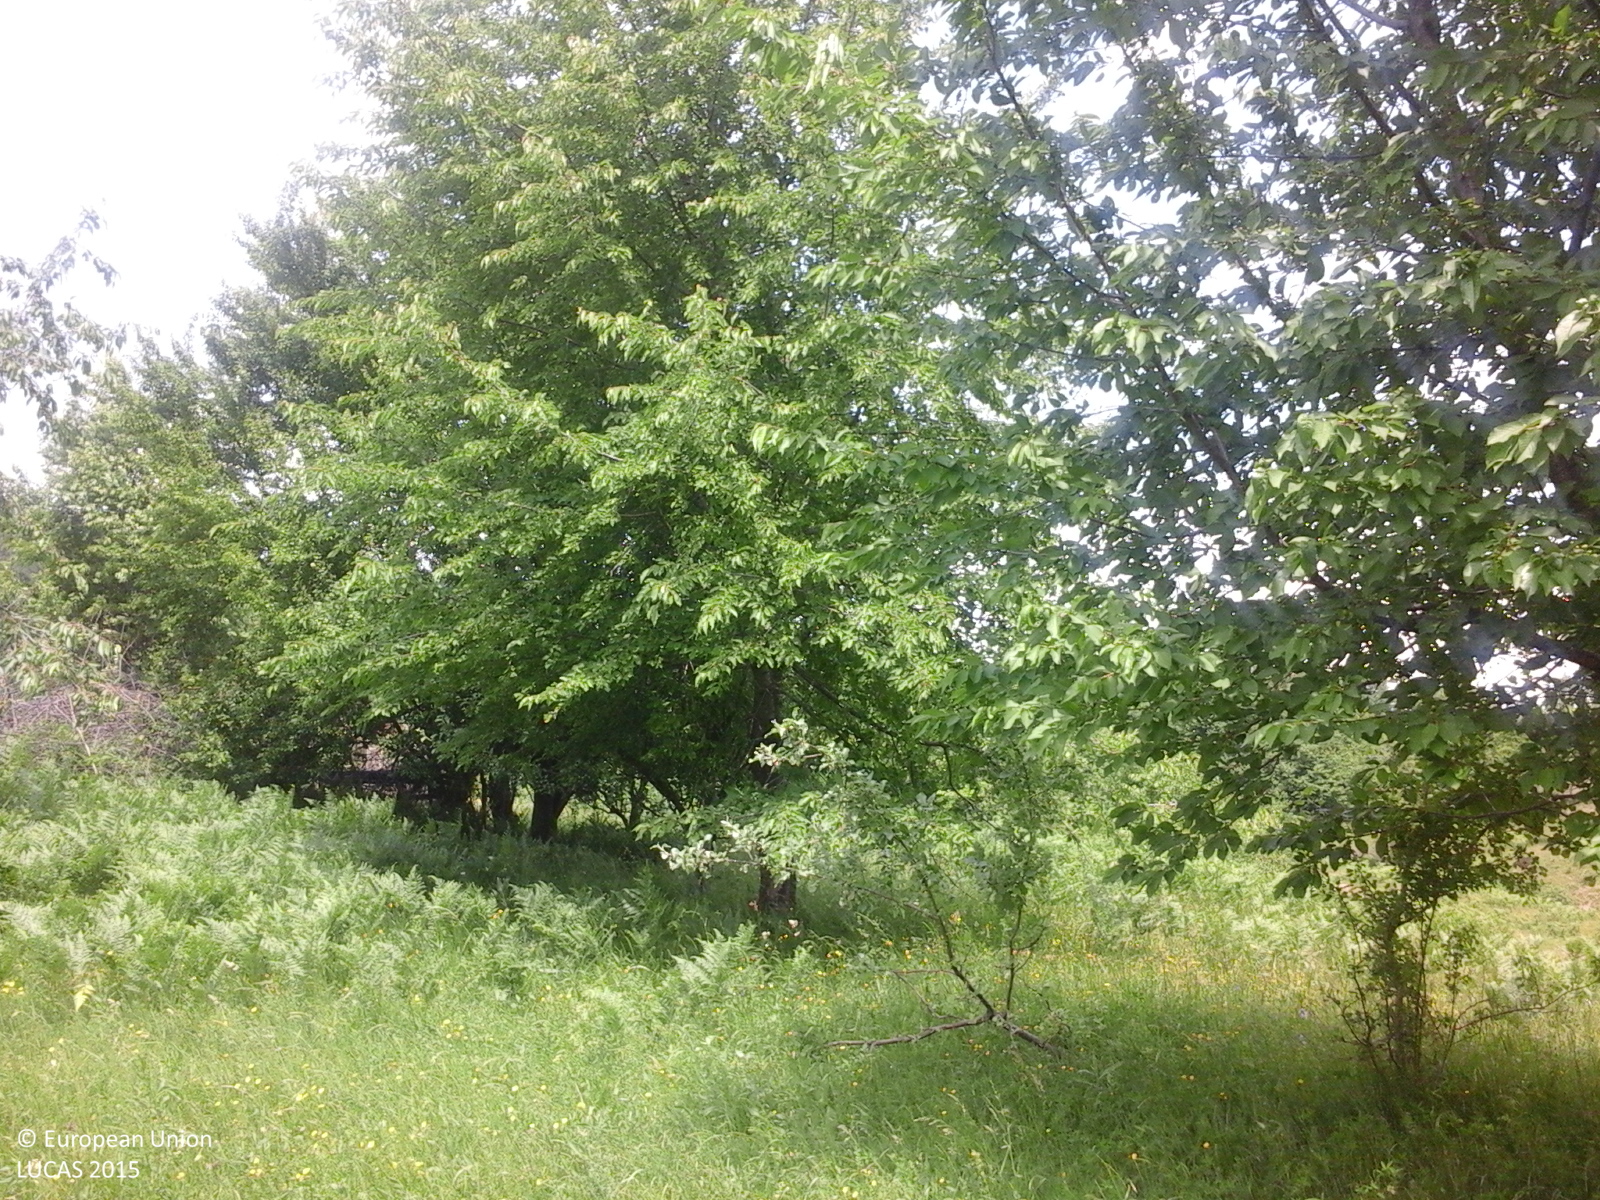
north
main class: Grassland
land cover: Grassland without tree/shrub cover
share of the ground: > 75 %
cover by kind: herbaceous plants 100 %
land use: Agriculture (excluding fallow land and kitchen gardens)
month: June
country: RO
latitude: 46.3575
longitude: 26.4151
